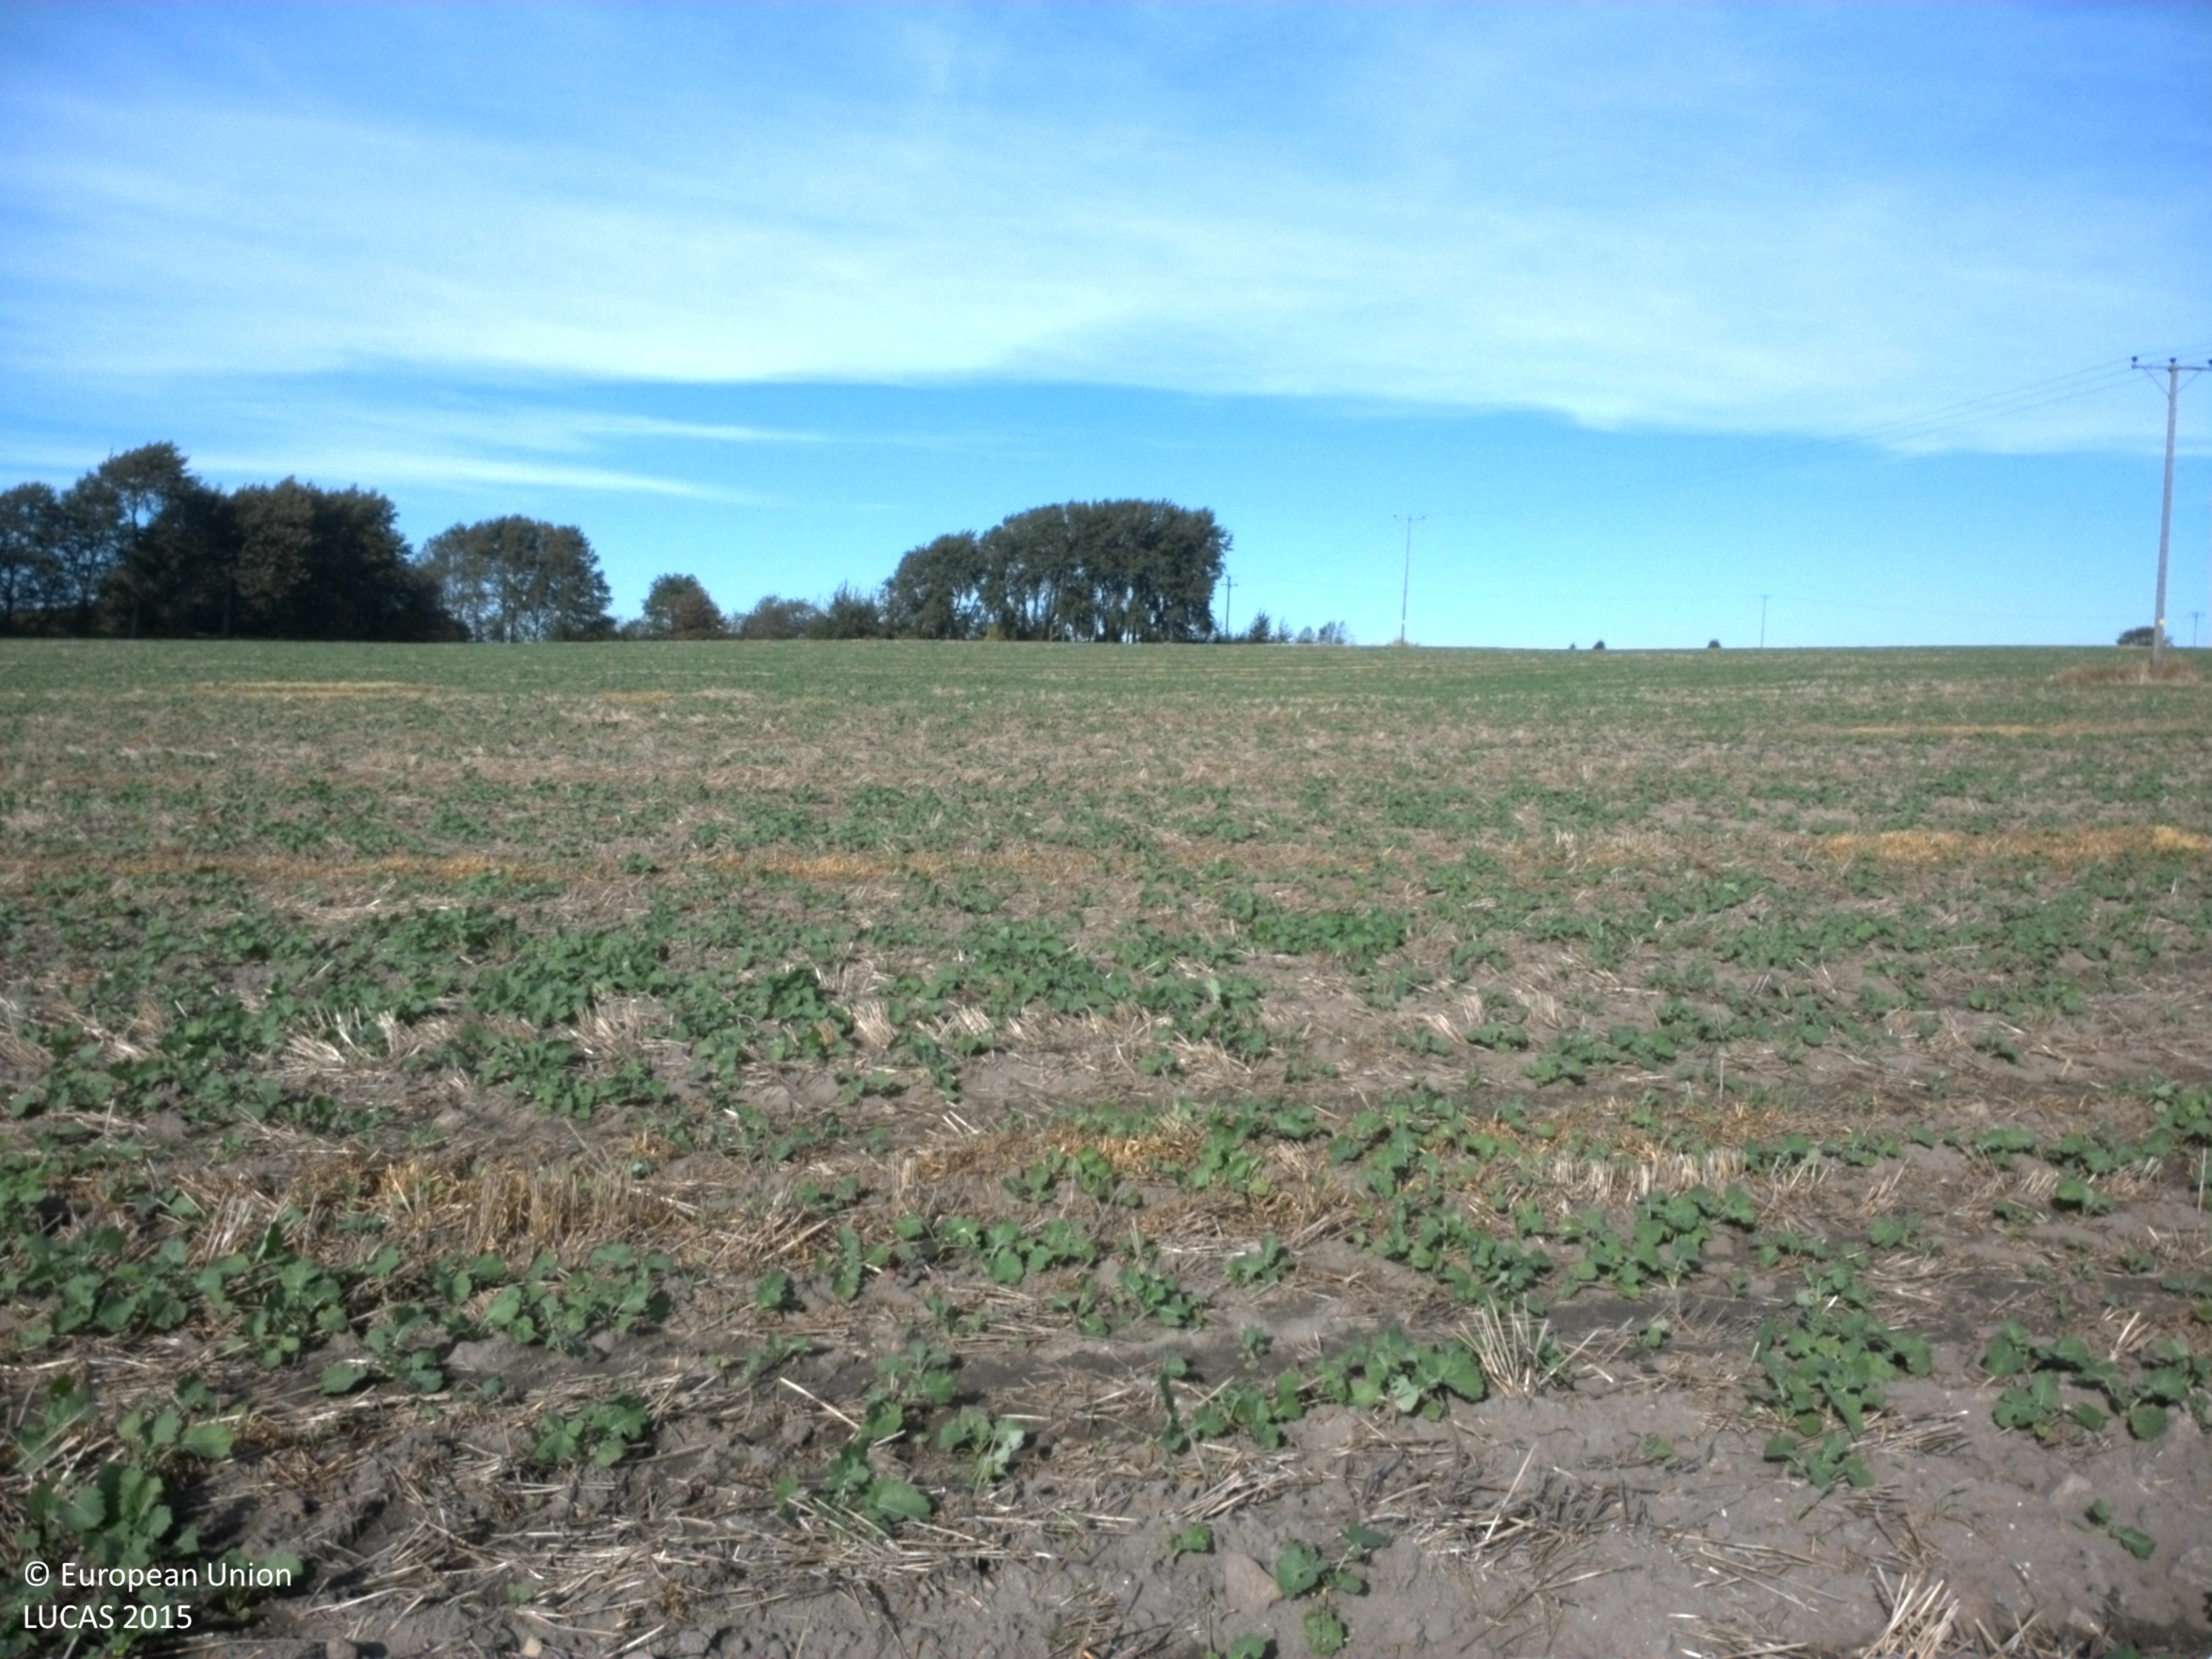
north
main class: Cropland
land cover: Rape and turnip rape
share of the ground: 25 - 50 %
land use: Agriculture (excluding fallow land and kitchen gardens)
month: October
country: SE
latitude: 55.7751
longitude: 13.6806
